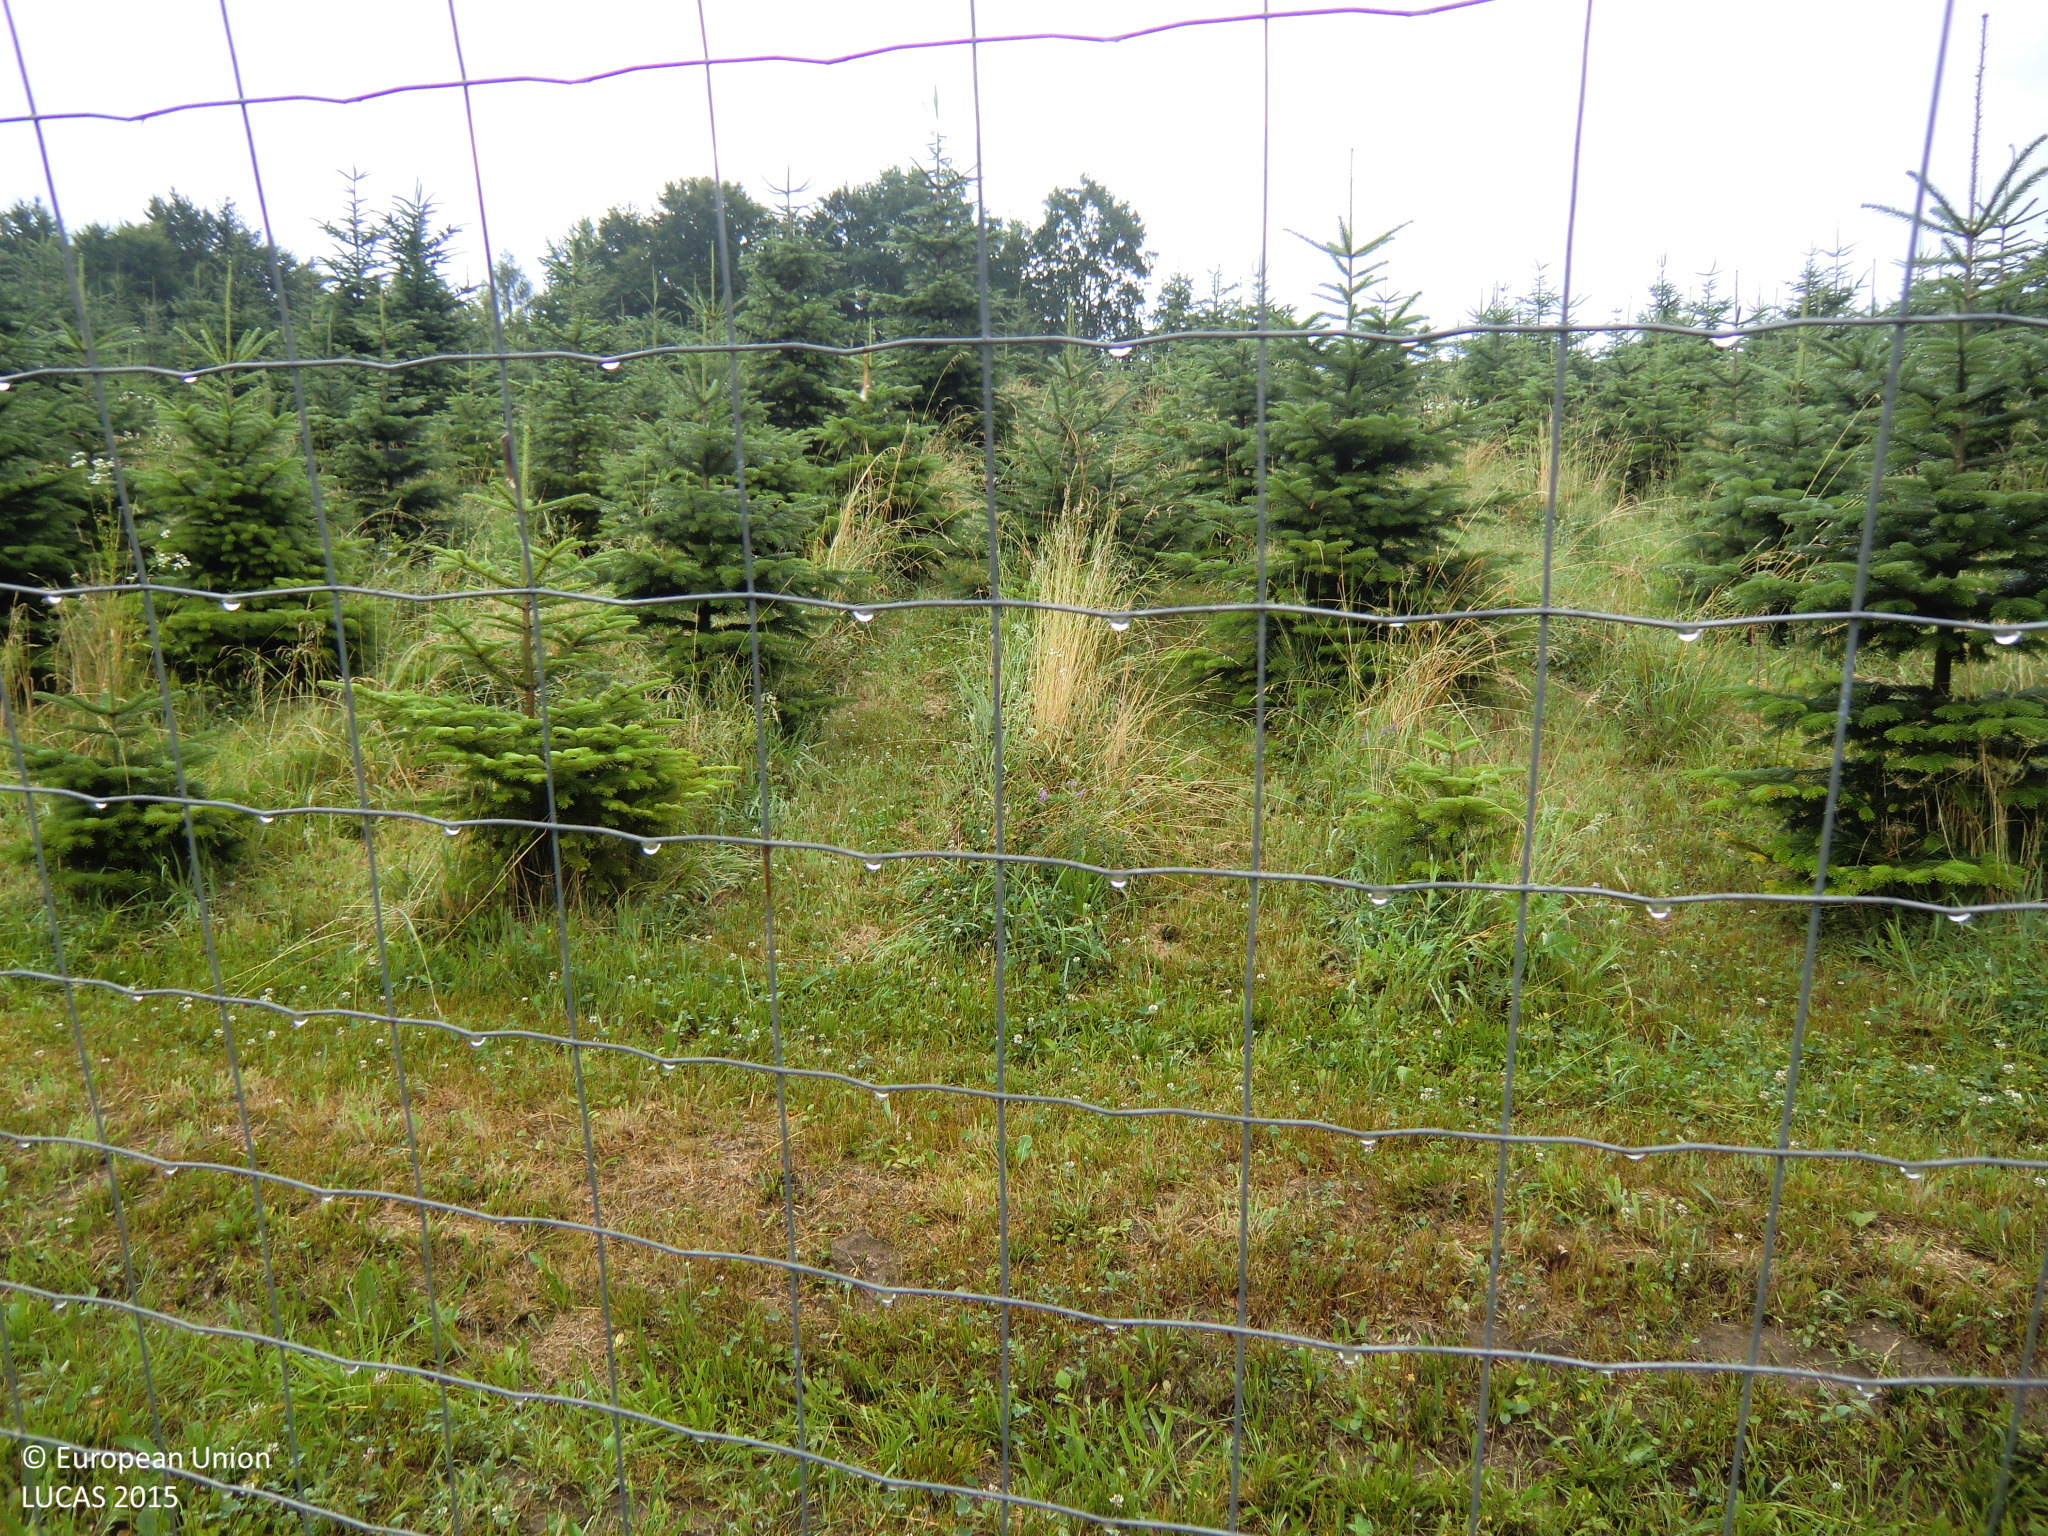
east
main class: Cropland
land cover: Apple fruit
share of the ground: 50 - 75 %
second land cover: Grassland without tree/shrub cover
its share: > 75 %
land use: Agriculture (excluding fallow land and kitchen gardens)
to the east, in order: Apple fruit; Grassland without tree/shrub cover; Fences; Grassland without tree/shrub cover; Other coniferous woodland; Fences; Grass margins; Paved roads, cycling and walking lanes; Grassland without tree/shrub cover; Broadleaved woodland; Pine dominated mixed woodland; Spruce dominated mixed woodland; Grassland without tree/shrub cover; Artificial constructions in urban areas; Grassland without tree/shrub cover; Temporary grasslands
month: July
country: AT
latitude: 47.0184
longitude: 15.9077
